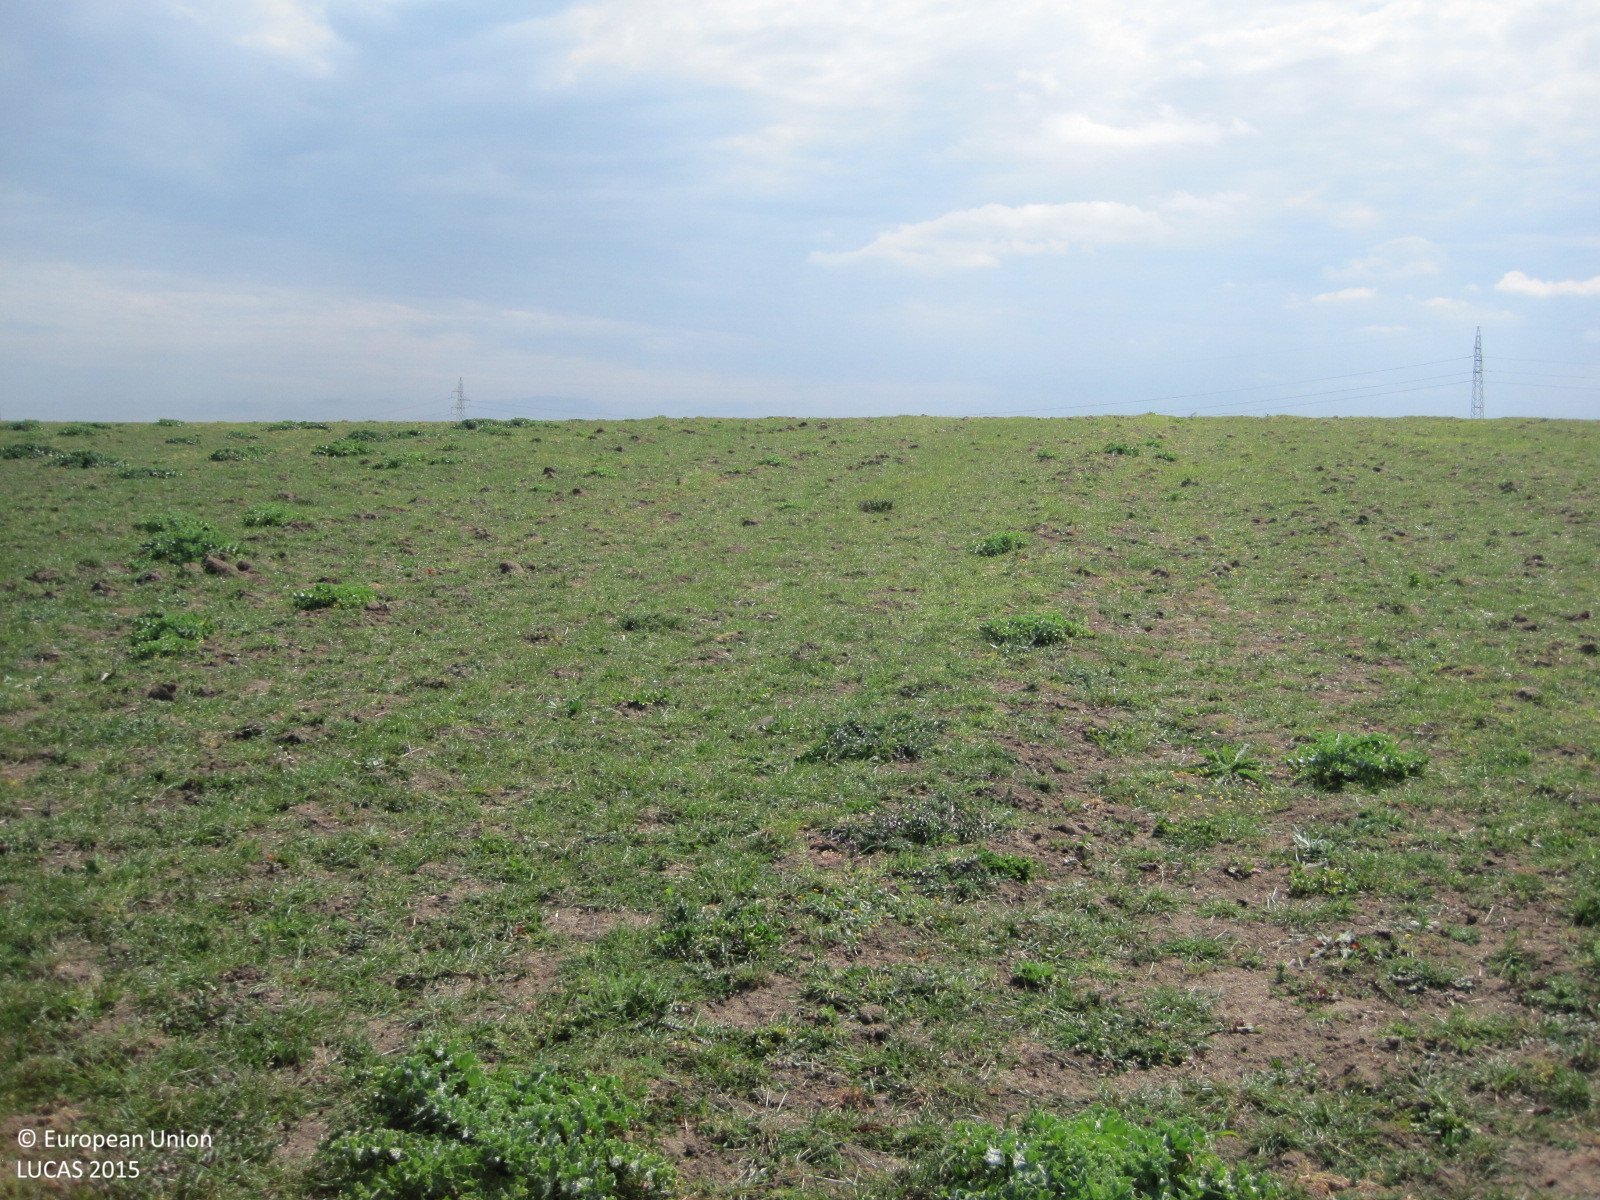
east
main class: Grassland
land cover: Grassland without tree/shrub cover
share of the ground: > 75 %
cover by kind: herbaceous plants 90 %, unconsolidated bare surface 10 %
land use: Agriculture (excluding fallow land and kitchen gardens)
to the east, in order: Grassland without tree/shrub cover; Grass margins; Other bare soil
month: April
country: ES
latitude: 39.8527
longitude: -5.0456
